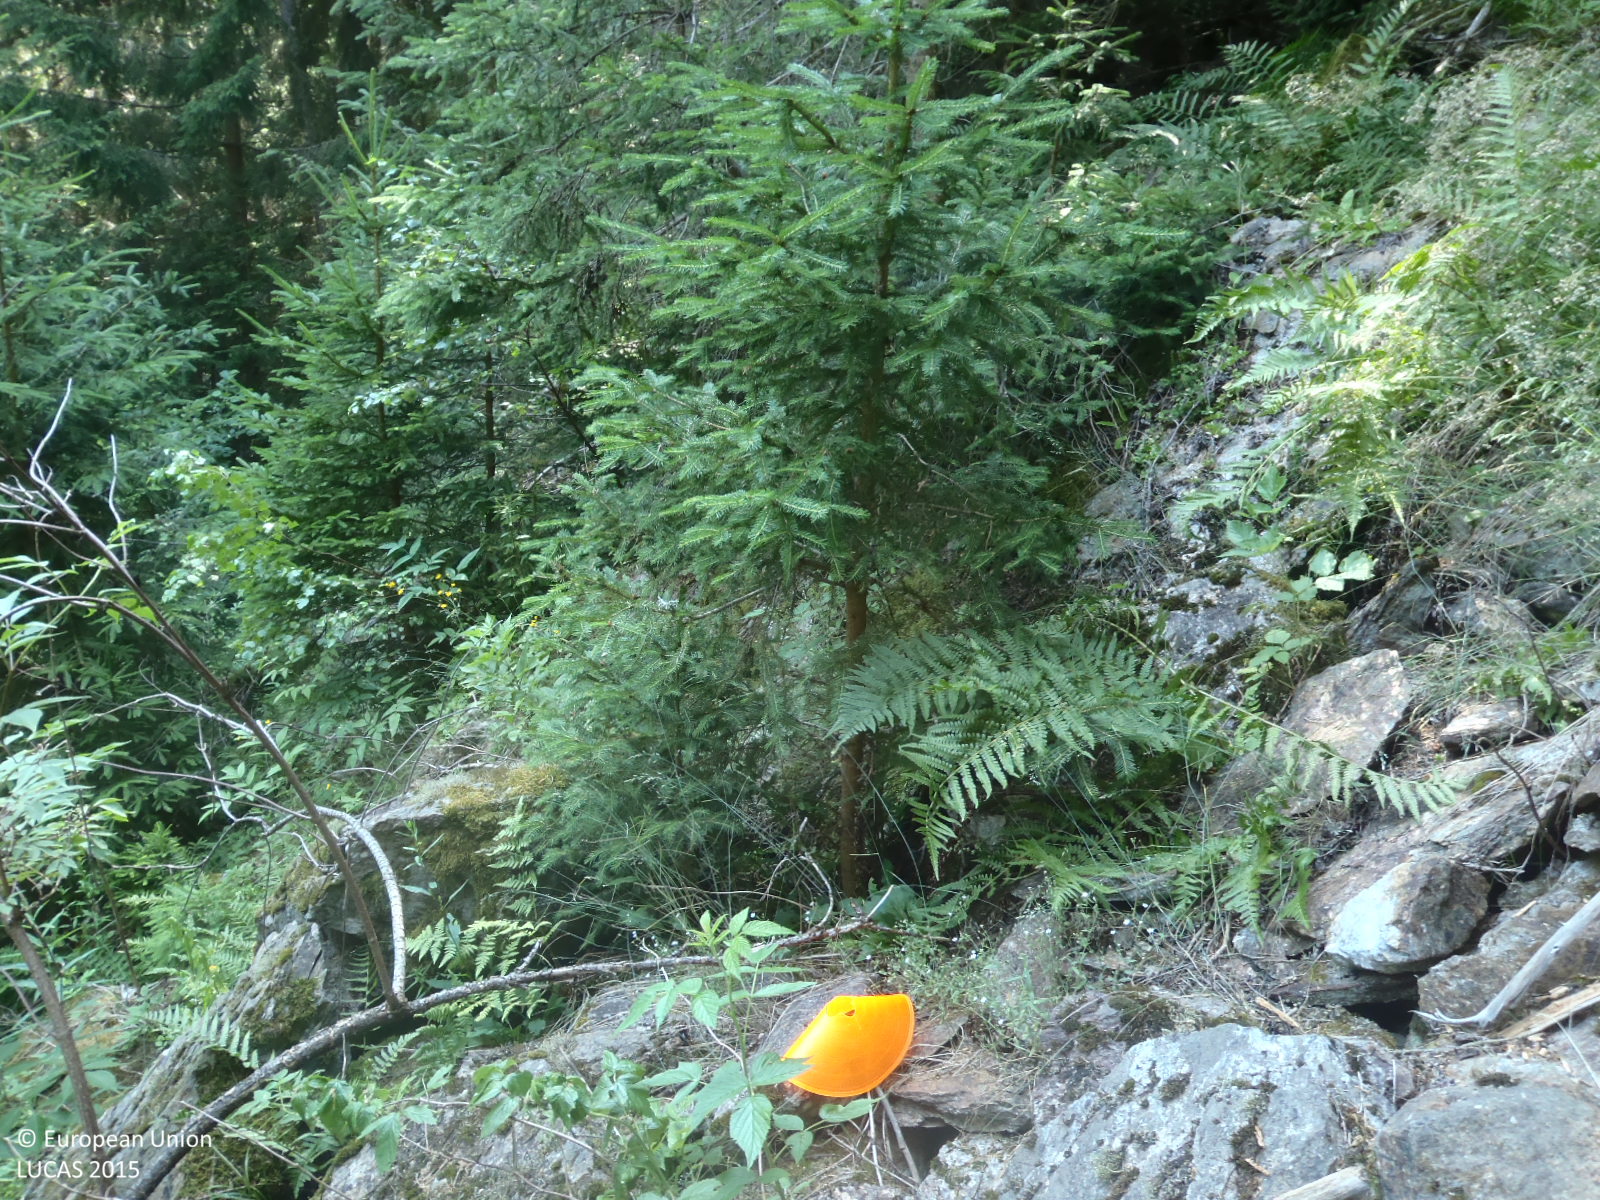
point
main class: Woodland
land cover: Spruce dominated coniferous woodland
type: alpine coniferous forest
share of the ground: > 75 %
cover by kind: coniferous forest trees 80 %, broadleaved forest trees 5 %, shrubs 5 %, herbaceous plants 5 %, consolidated bare surface 5 %
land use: Forestry
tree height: > 5 m
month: July
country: AT
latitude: 47.0708
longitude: 10.4078
